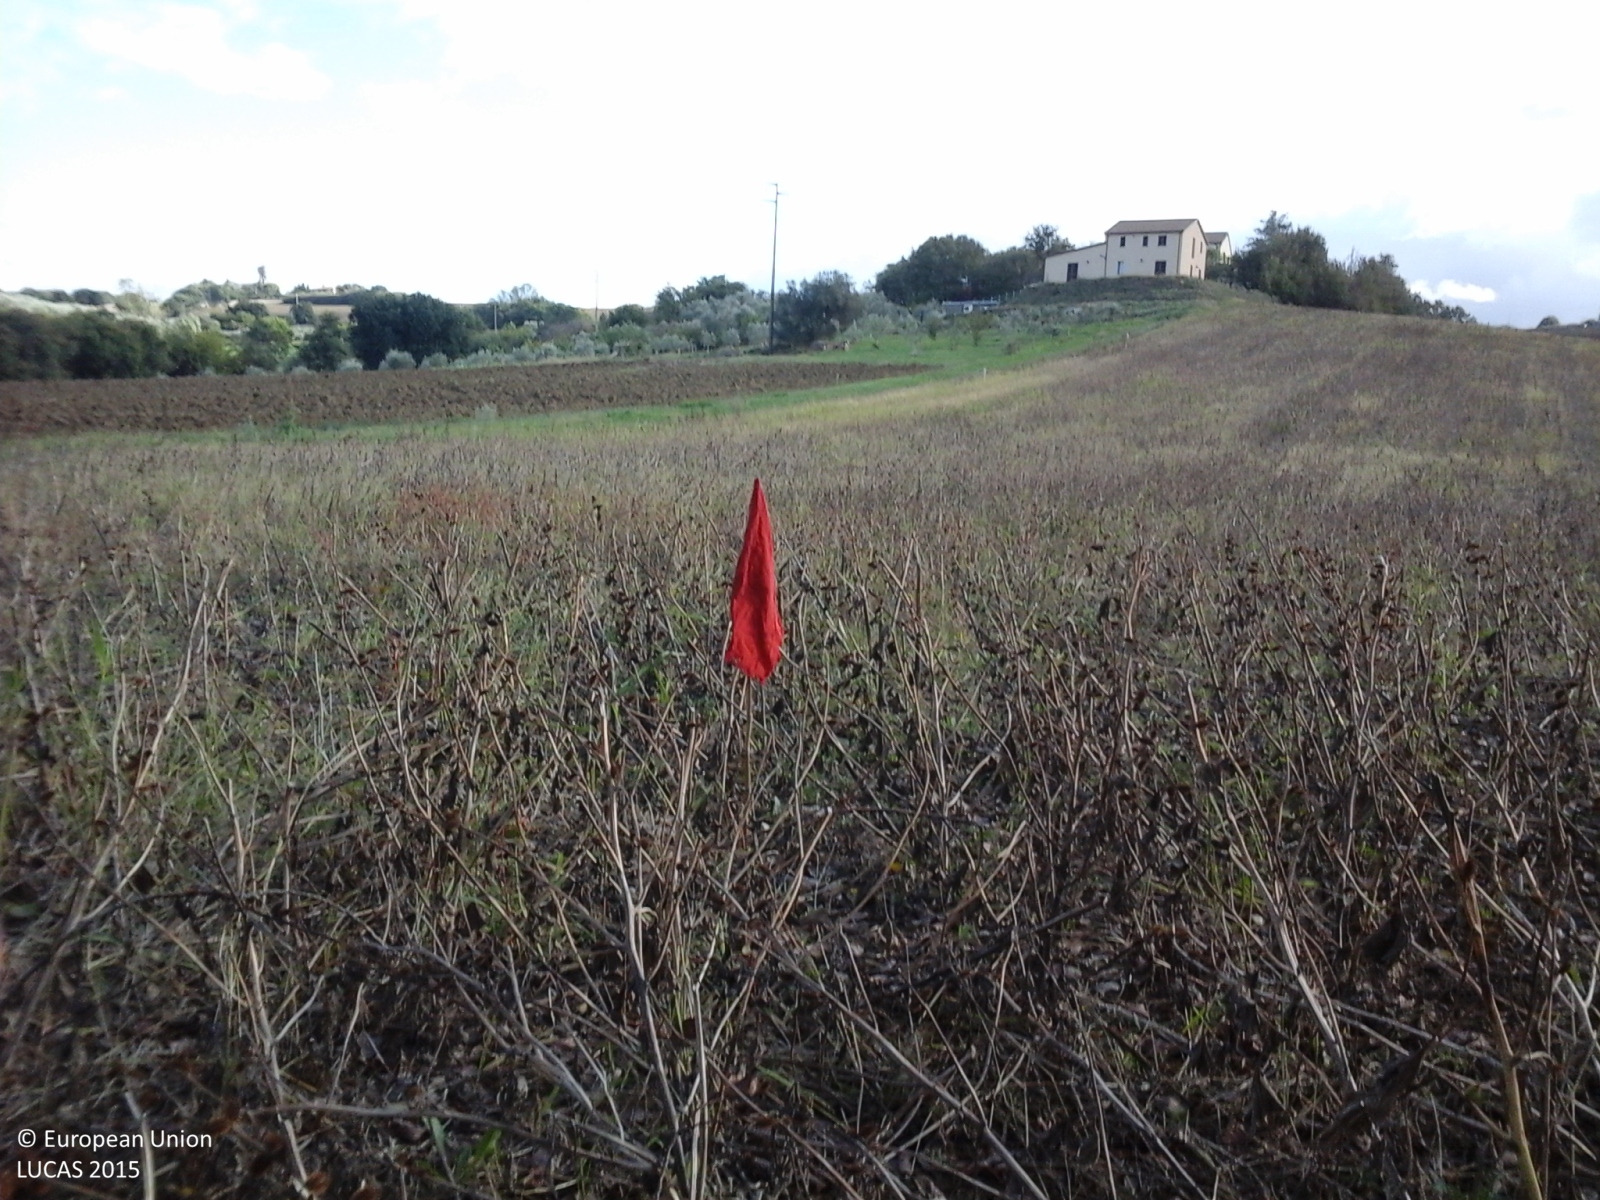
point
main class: Cropland
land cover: Sunflower
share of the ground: 25 - 50 %
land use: Agriculture (excluding fallow land and kitchen gardens)
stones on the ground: < 10 %
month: October
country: IT
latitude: 43.6489
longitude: 13.2777
